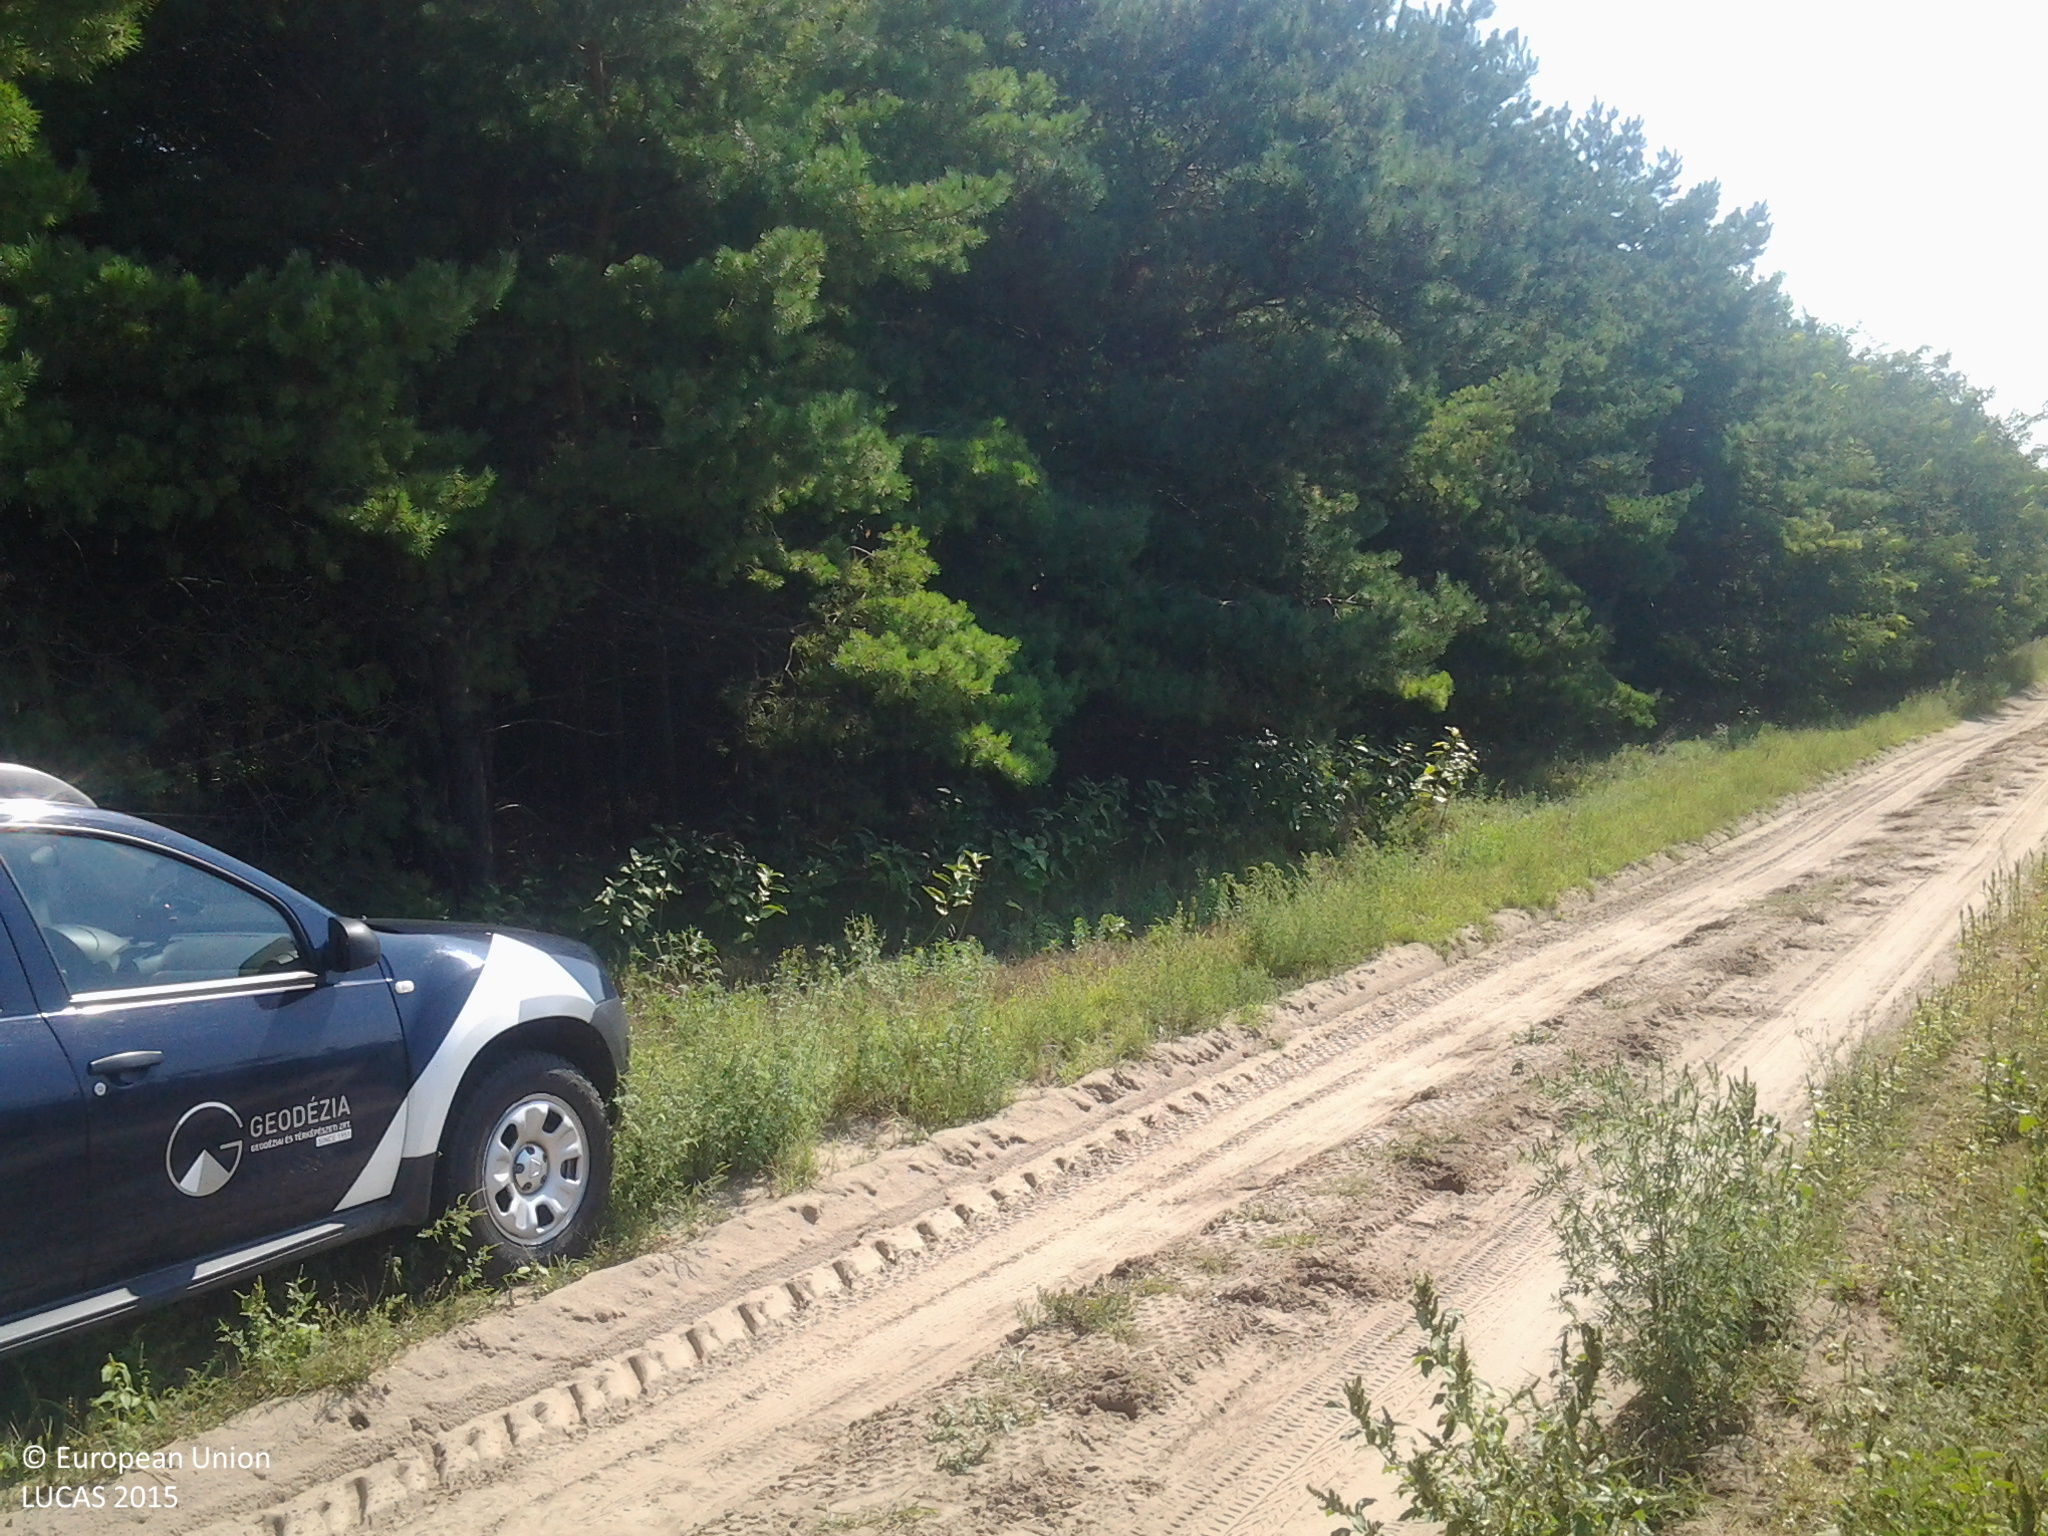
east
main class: Woodland
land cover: Pine dominated coniferous woodland
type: hemiboreal forest and nemoral coniferous forest and mixed broadleaved-coniferous forest
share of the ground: > 75 %
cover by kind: coniferous forest trees 100 %
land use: Forestry
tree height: > 5 m
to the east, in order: Tracks; Grass margins; Spruce dominated coniferous woodland; Tracks; Spruce dominated coniferous woodland
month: August
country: HU
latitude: 46.7310
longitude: 19.6375
